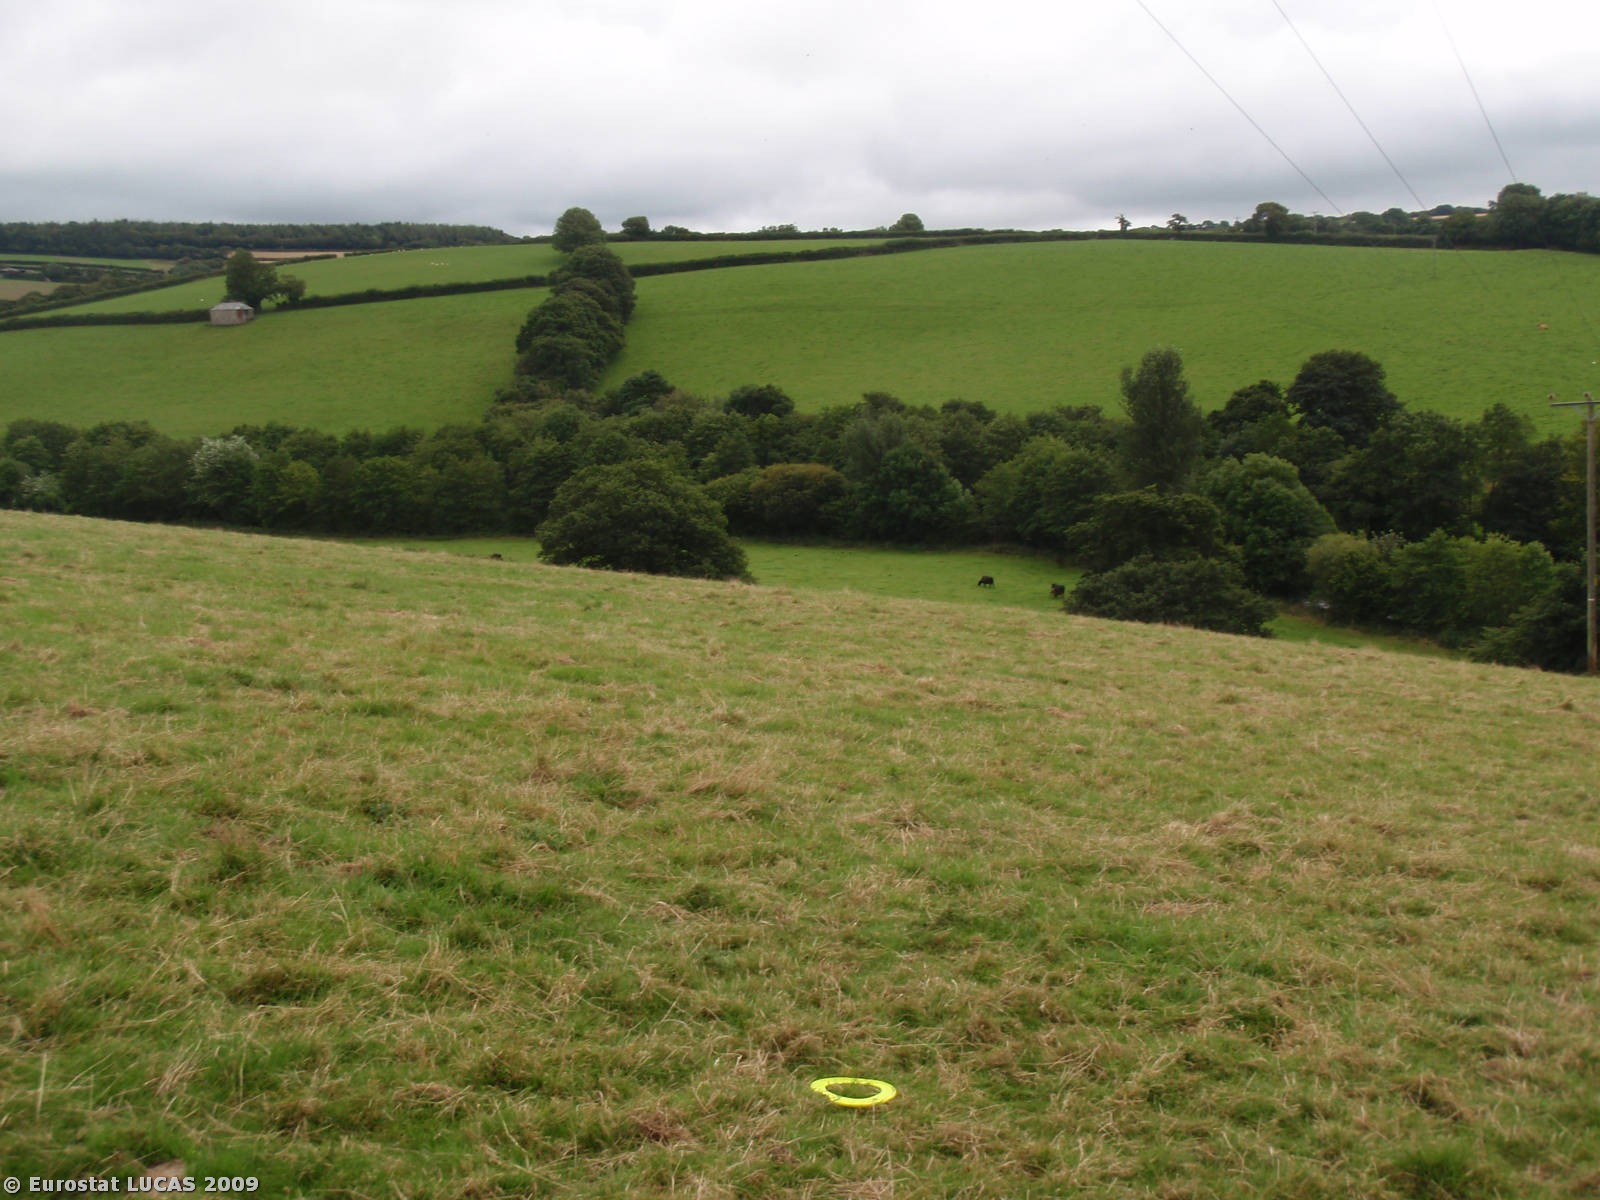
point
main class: Grassland
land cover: Grassland without tree/shrub cover
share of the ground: > 75 %
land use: Agriculture (excluding fallow land and kitchen gardens)
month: August
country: GB
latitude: 50.5714
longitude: -4.3190
